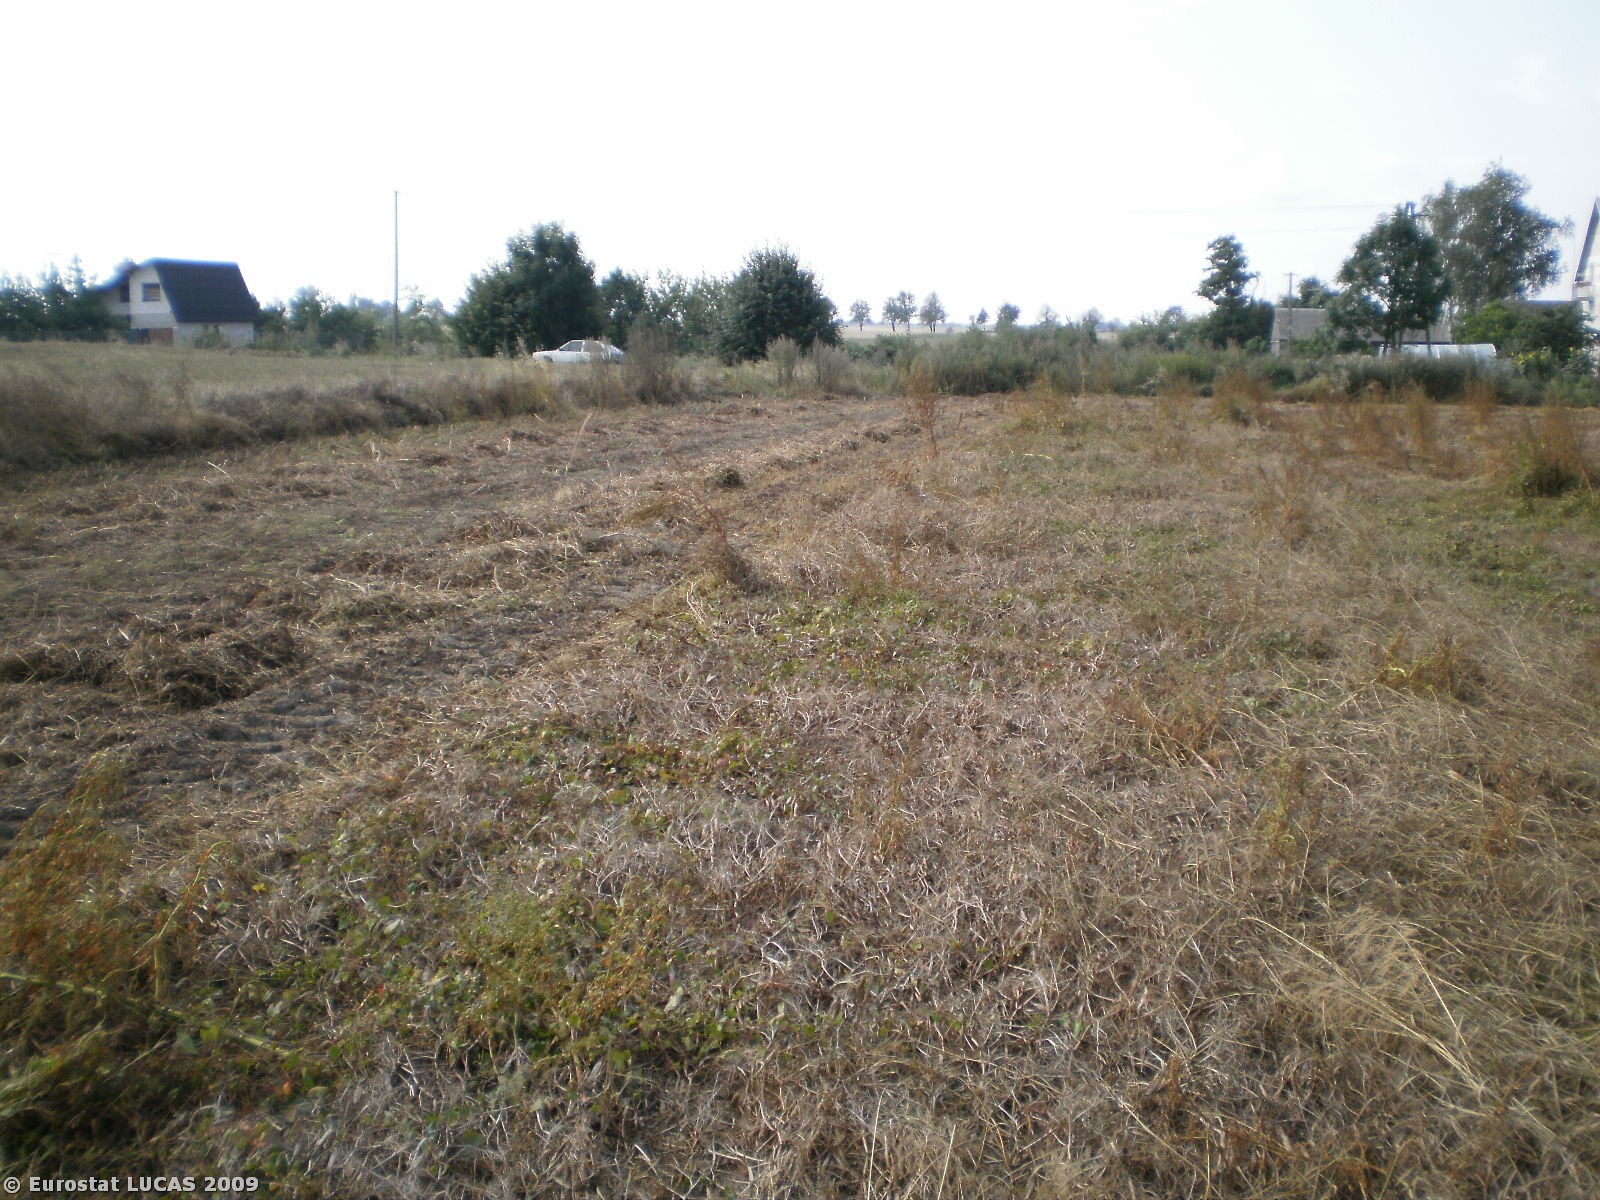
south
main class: Cropland
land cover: Dry pulses
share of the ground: > 75 %
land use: Agriculture (excluding fallow land and kitchen gardens)
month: August
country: PL
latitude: 52.9346
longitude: 21.0092
